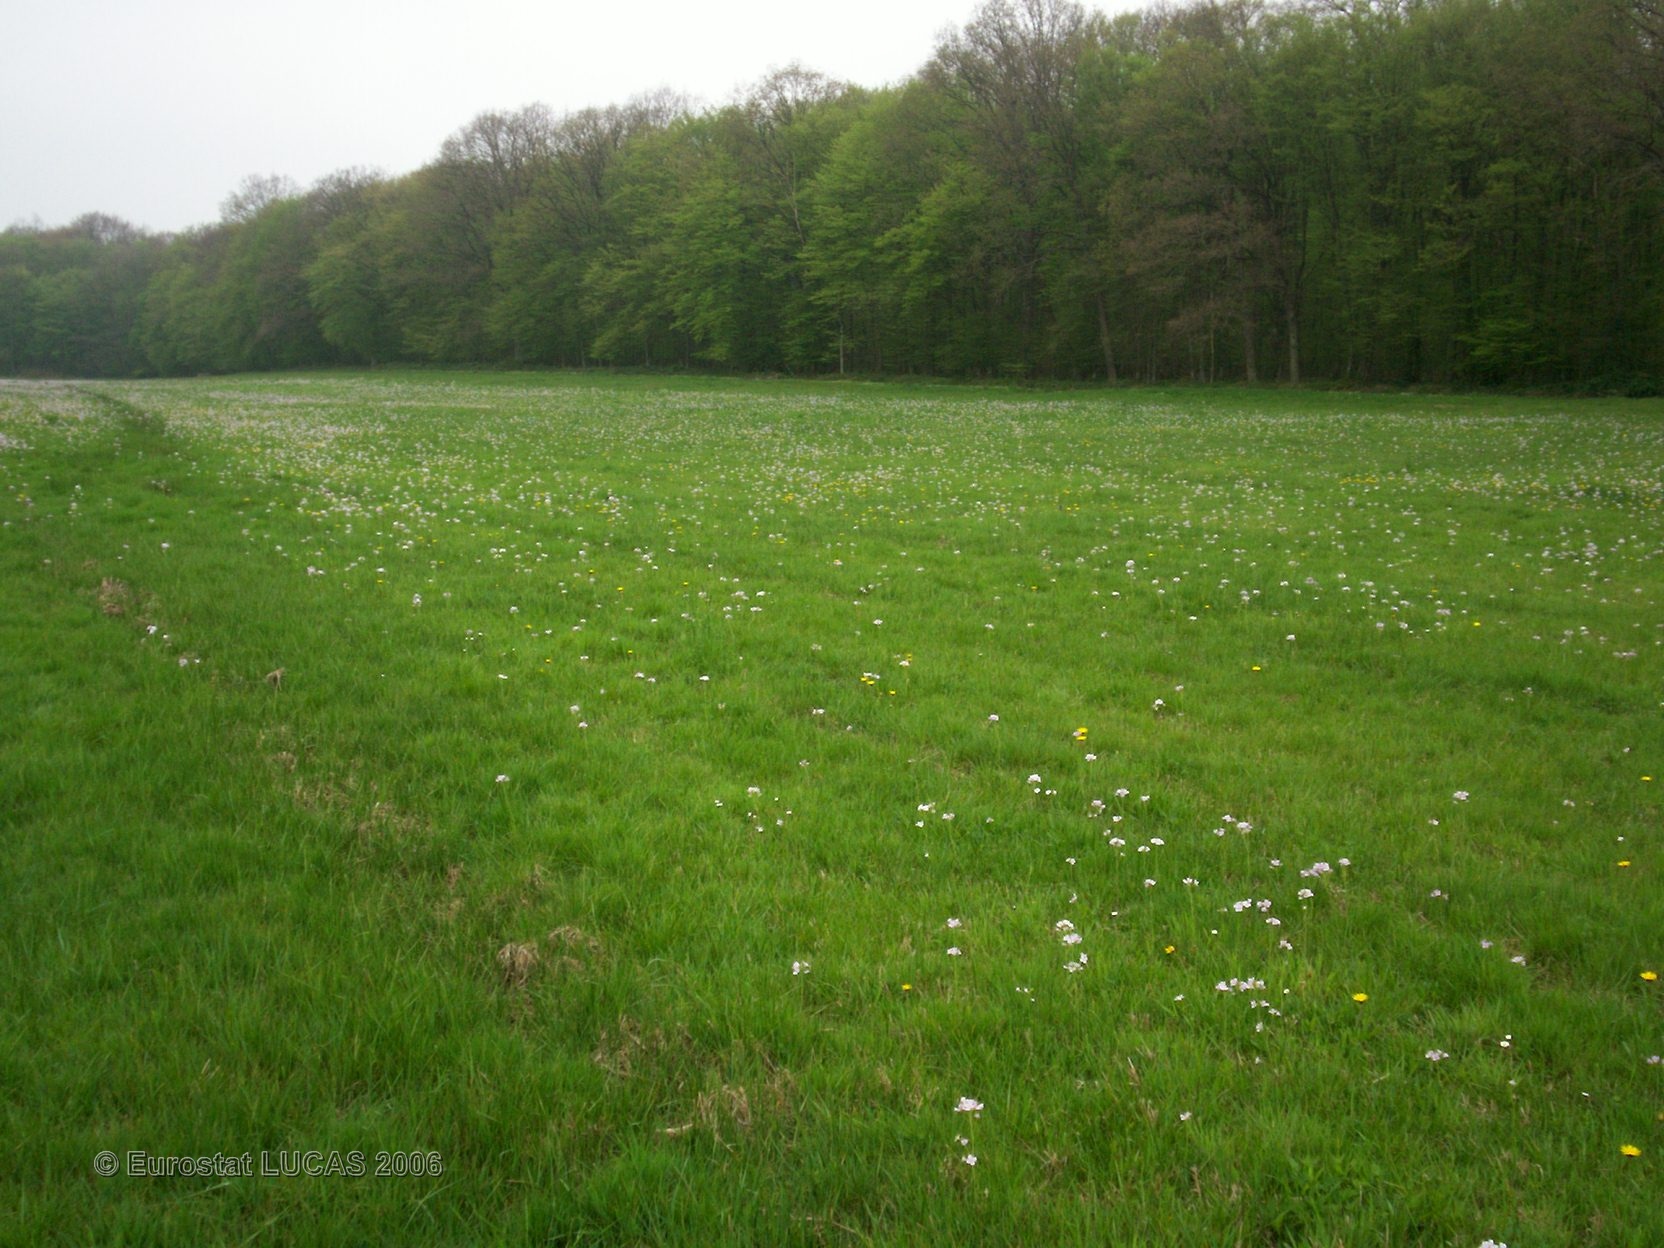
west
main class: Grassland
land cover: Grassland without tree/shrub cover
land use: Agriculture (excluding fallow land and kitchen gardens)
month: April
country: FR
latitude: 48.9136
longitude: 6.7391
